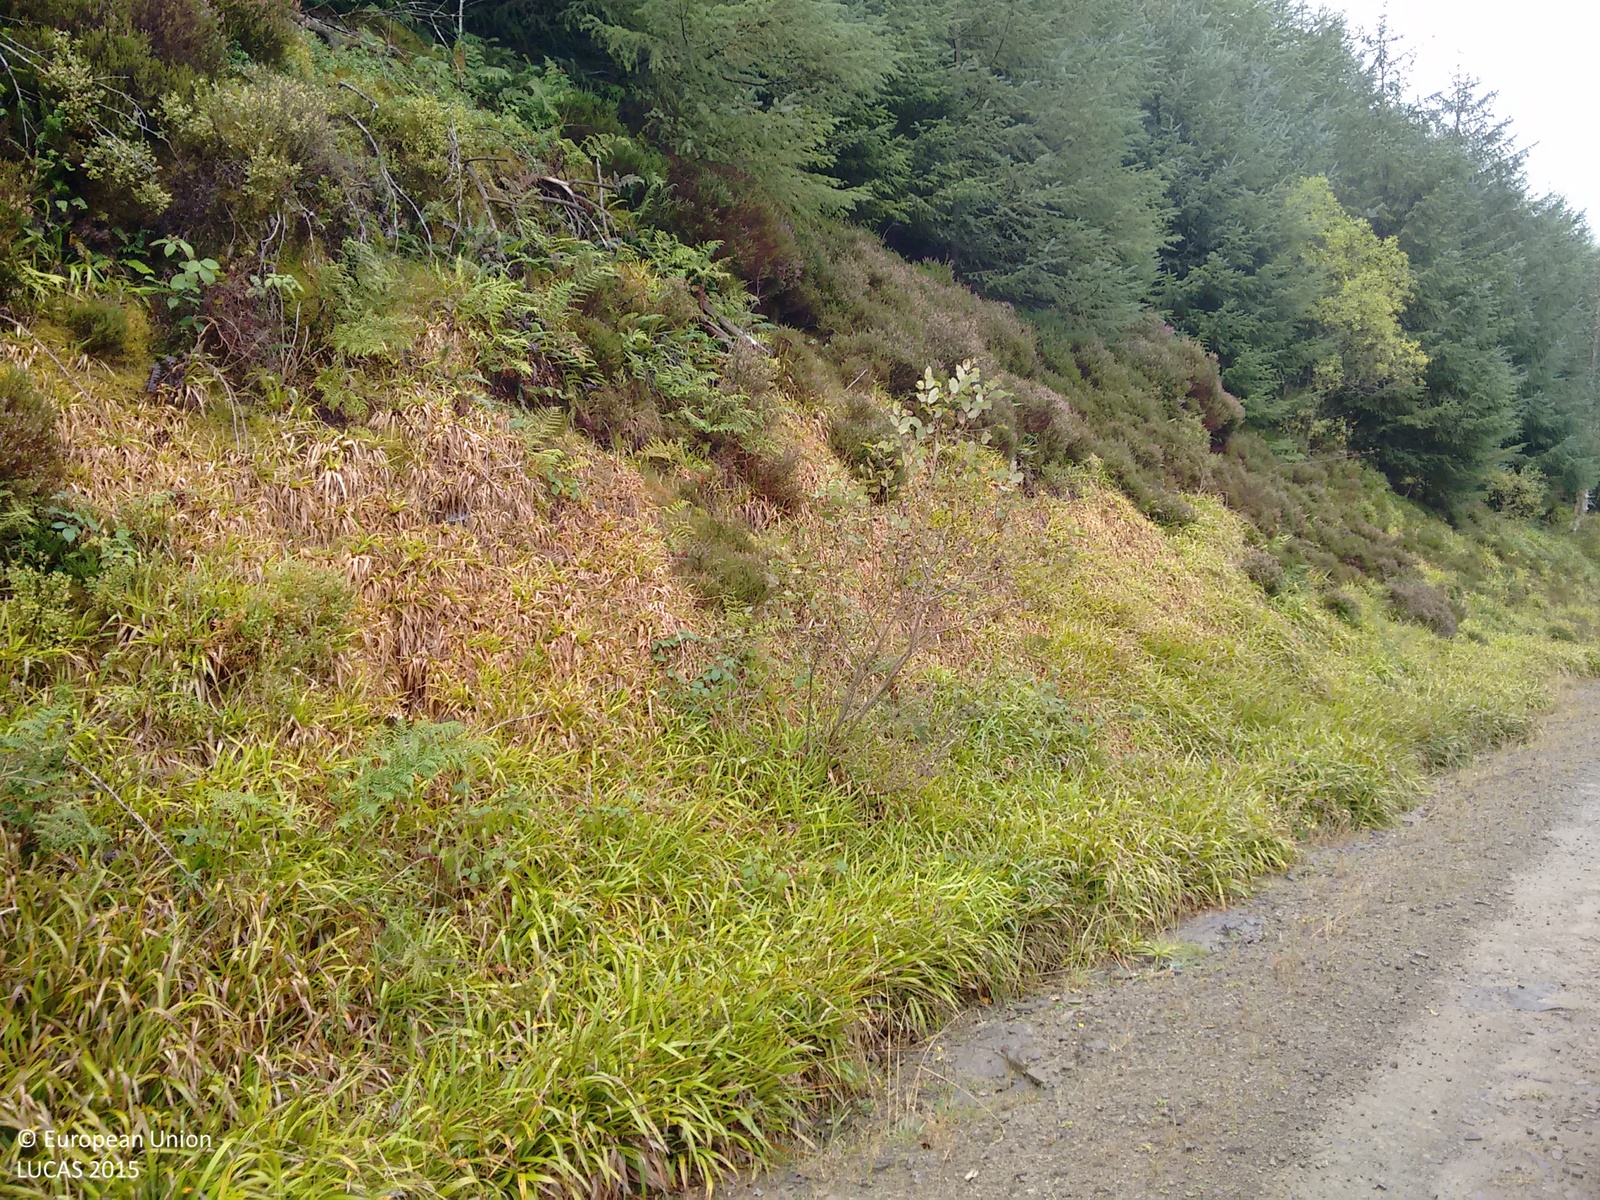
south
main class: Woodland
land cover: Pine dominated coniferous woodland
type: exotic forest
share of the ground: > 75 %
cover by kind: coniferous forest trees 80 %, shrubs 20 %
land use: Forestry
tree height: > 5 m
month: October
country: GB
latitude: 52.2779
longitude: -3.1667
